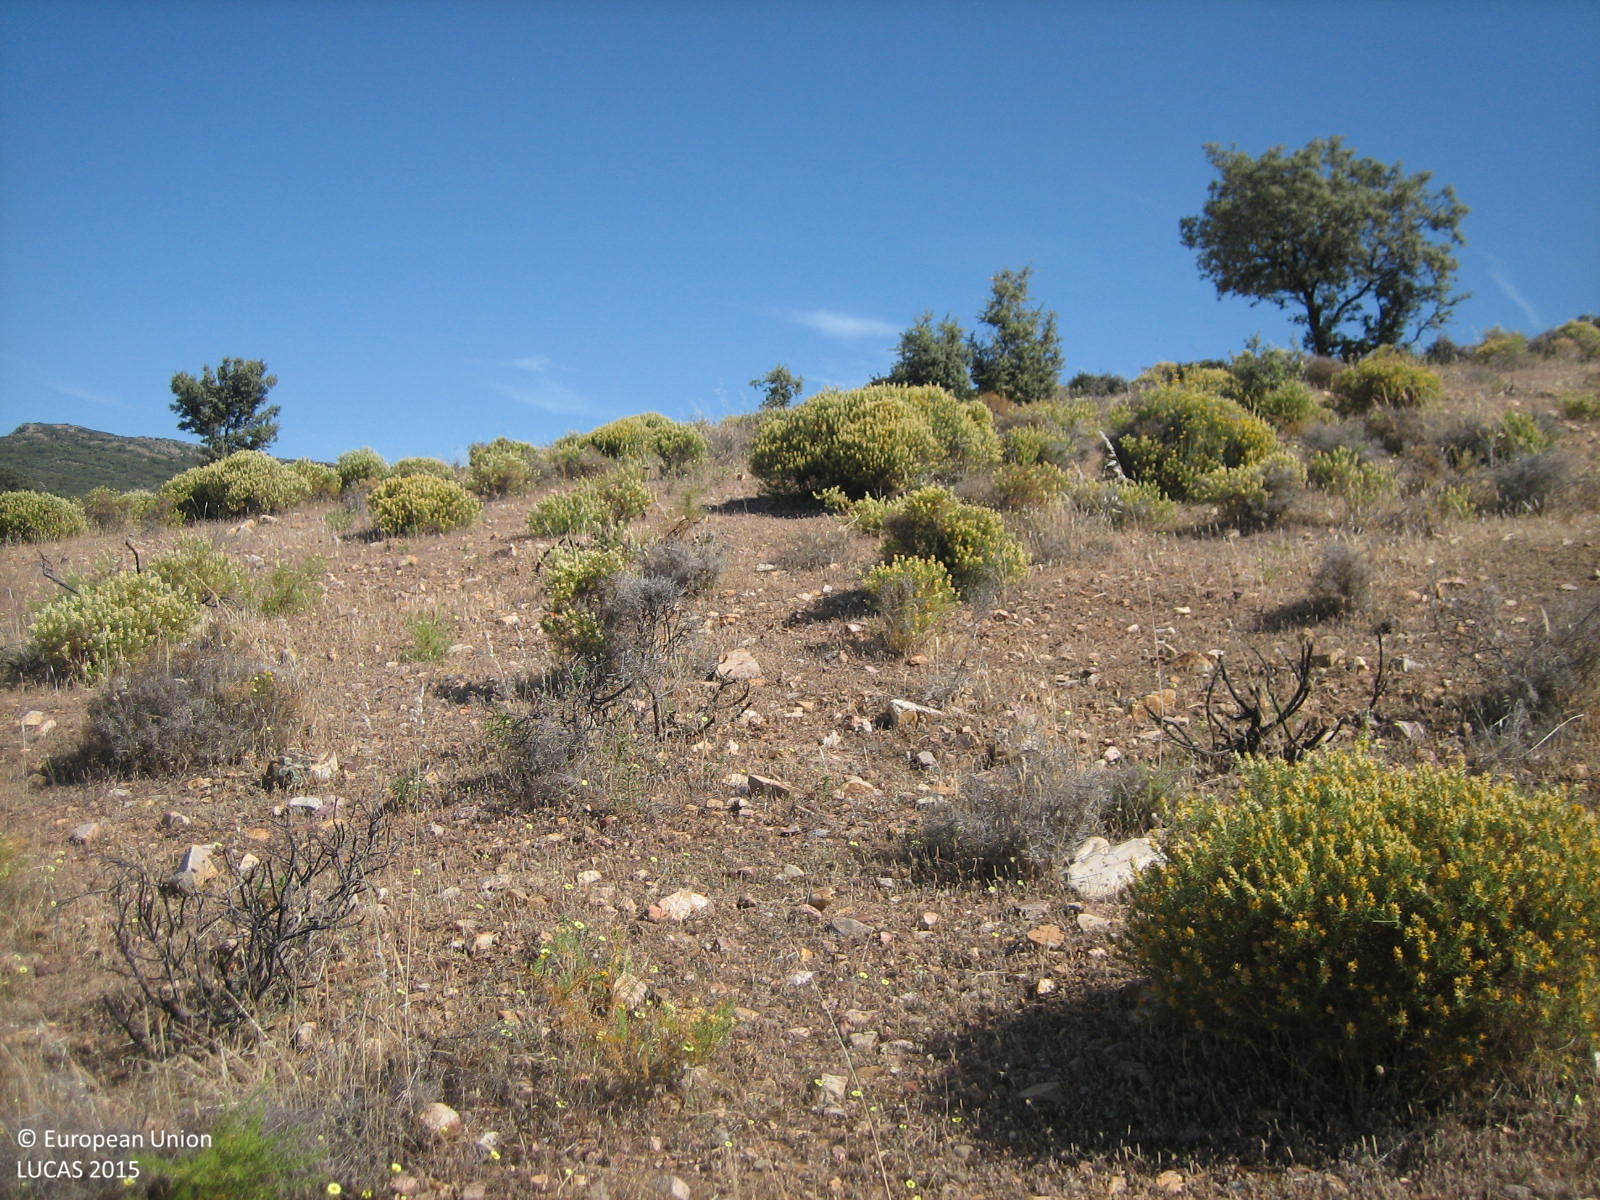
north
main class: Shrubland
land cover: Shrubland with sparse tree cover
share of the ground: 10 - 25 %
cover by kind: herbaceous plants 40 %, shrubs 30 %, consolidated bare surface 25 %, broadleaved forest trees 5 %
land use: Agriculture (excluding fallow land and kitchen gardens)
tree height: < 5 m
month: May
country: ES
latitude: 38.9274
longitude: -4.8547
